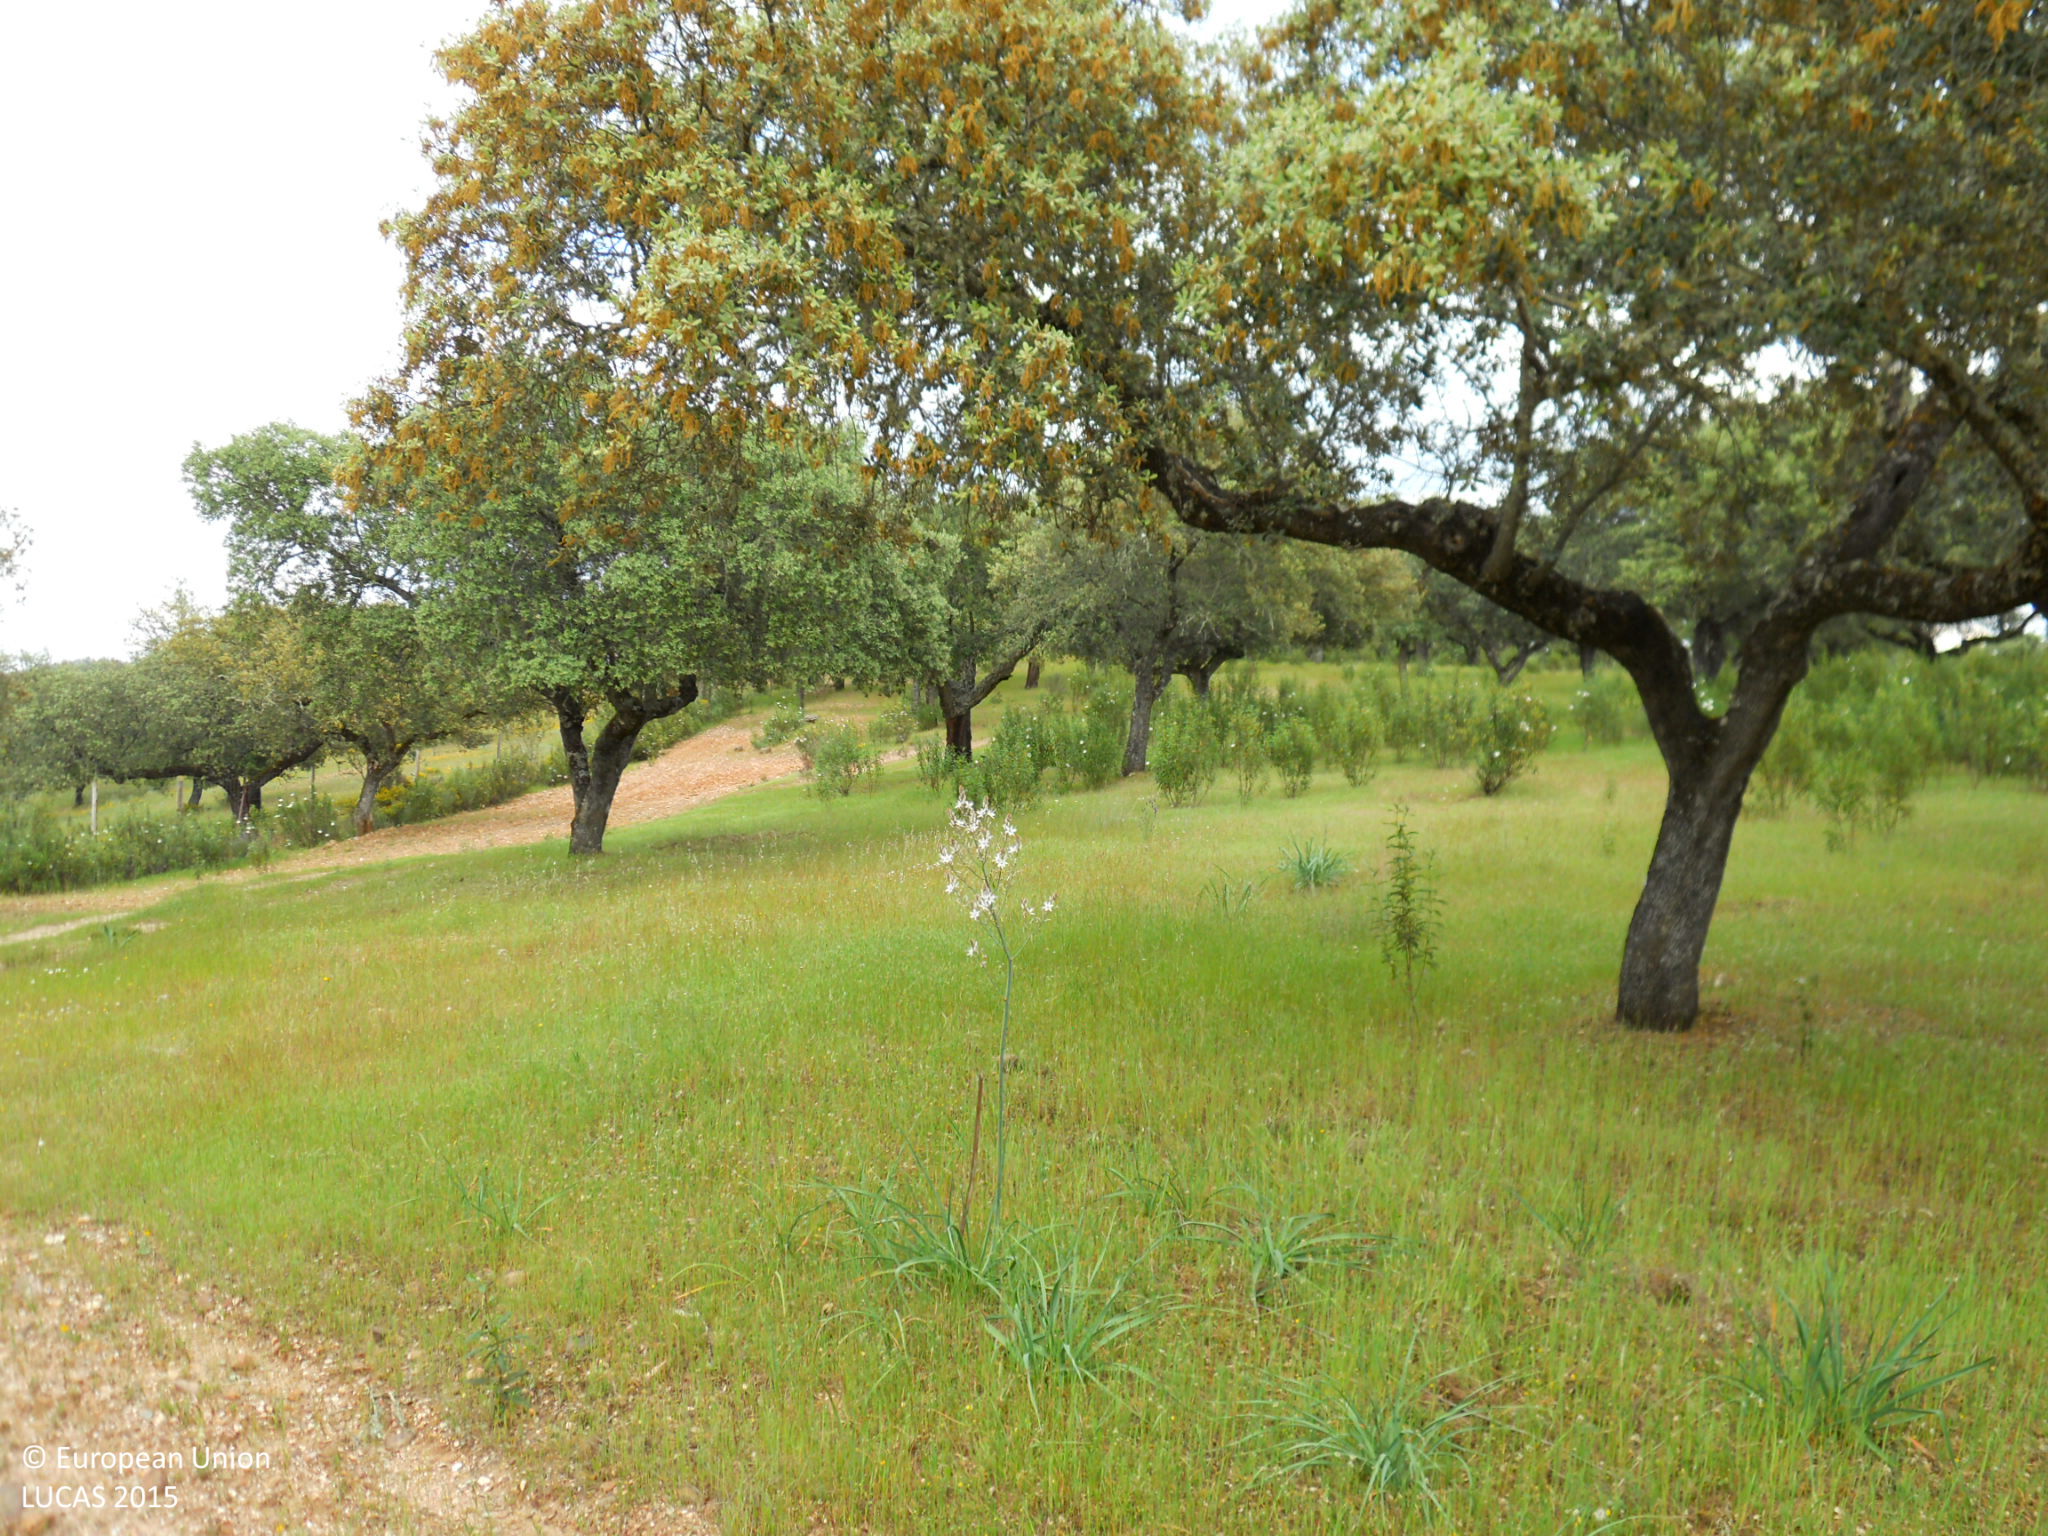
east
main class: Woodland
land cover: Broadleaved woodland
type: broadleaved evergreen forest
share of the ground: > 75 %
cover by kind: broadleaved forest trees 90 %, shrubs 5 %, consolidated bare surface 5 %
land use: Forestry
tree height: > 5 m
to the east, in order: Broadleaved woodland; Other structural elements; Broadleaved woodland
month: April
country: ES
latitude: 39.3073
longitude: -6.7849
